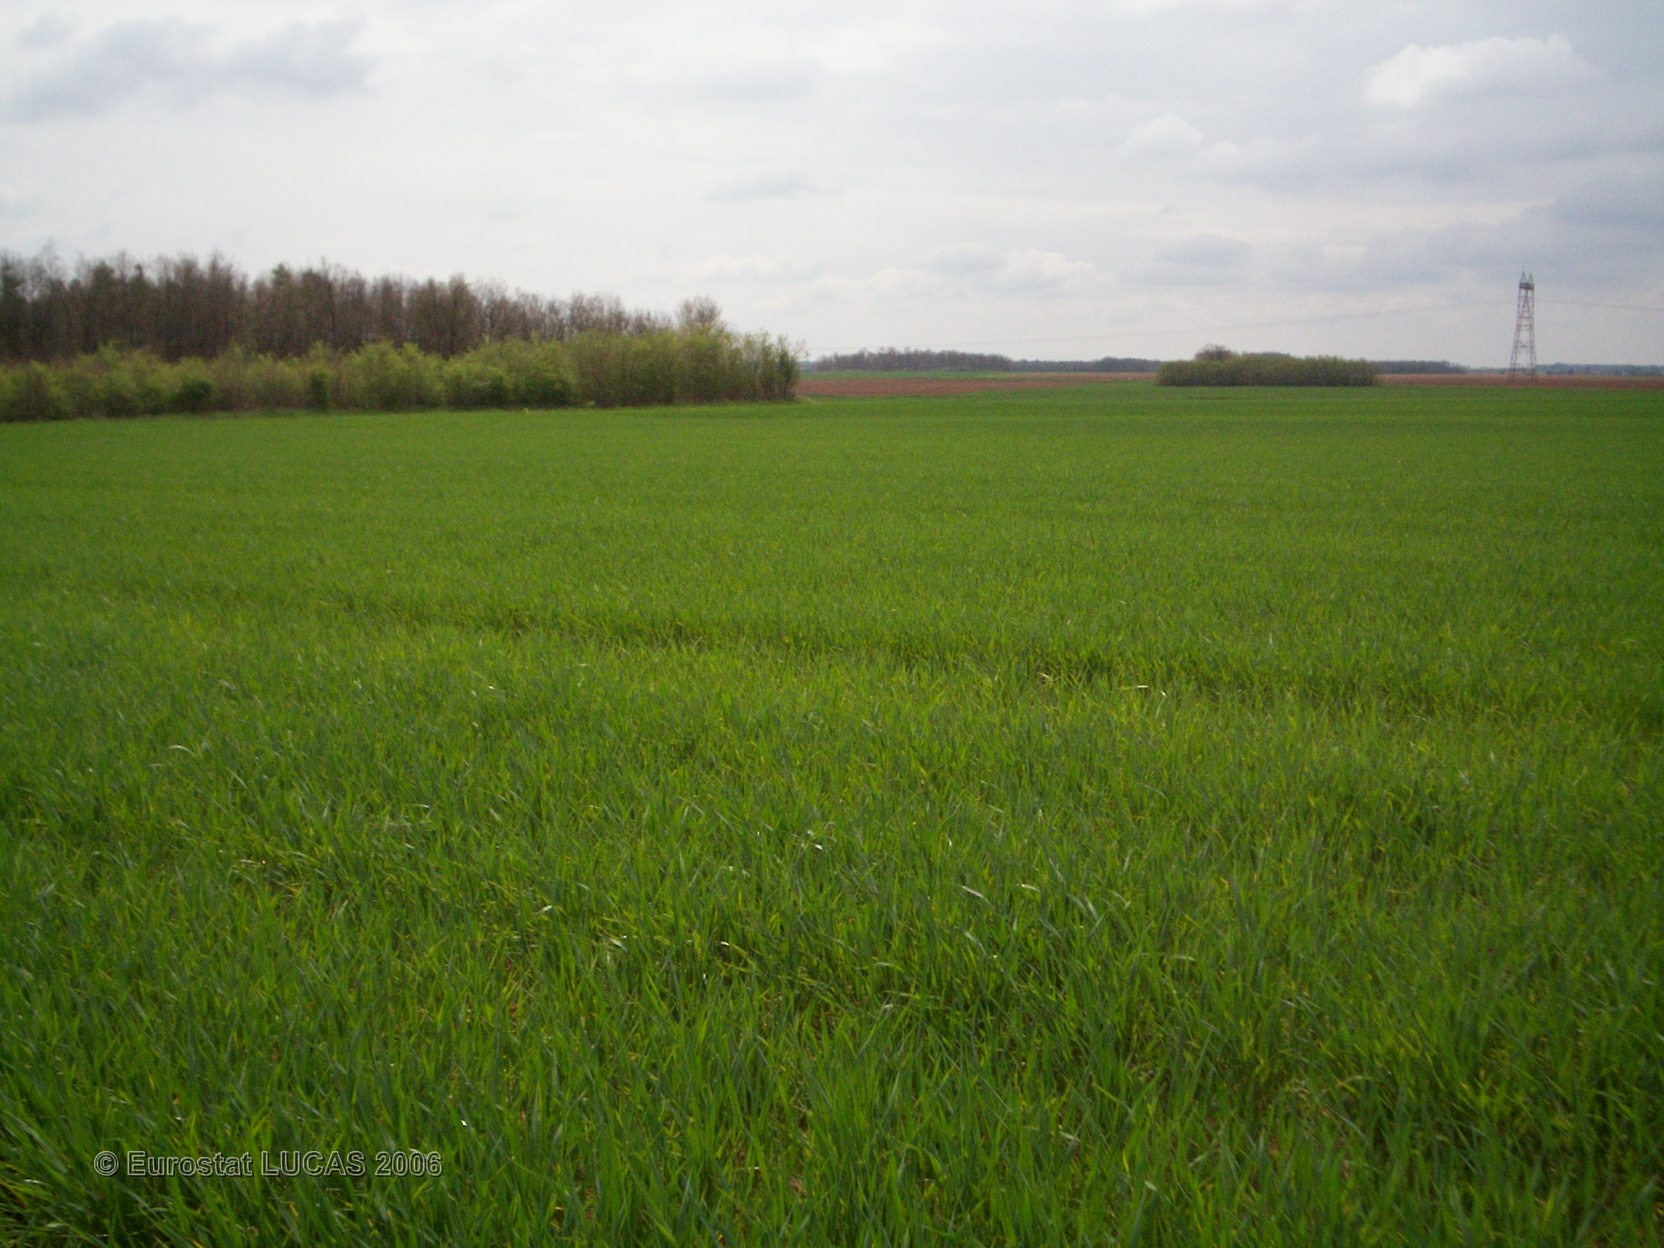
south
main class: Cropland
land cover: Barley
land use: Agriculture (excluding fallow land and kitchen gardens)
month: April
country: FR
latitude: 47.0449
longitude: 0.2248
